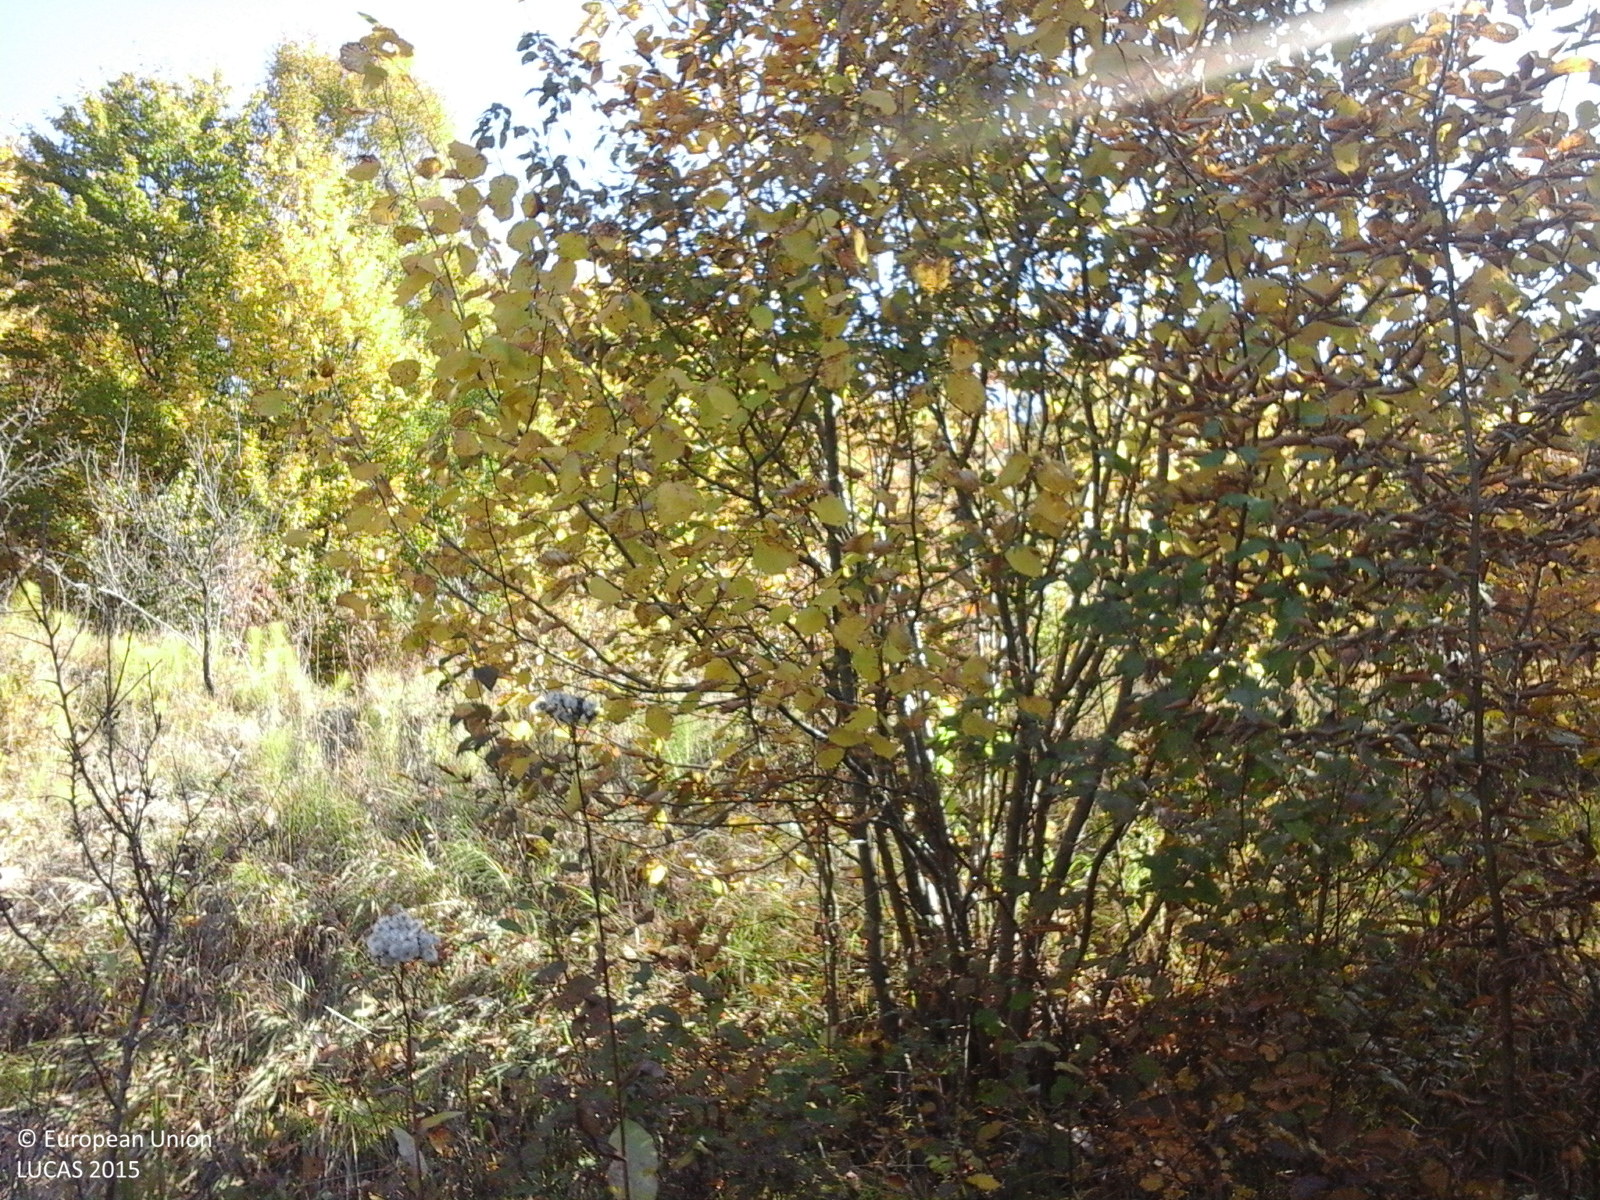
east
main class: Grassland
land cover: Grassland with sparse tree/shrub cover
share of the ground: > 75 %
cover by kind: herbaceous plants 85 %, shrubs 10 %, broadleaved forest trees 5 %
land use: Fallow land
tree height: < 5 m
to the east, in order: Grassland with sparse tree/shrub cover; Broadleaved woodland; Tracks; Broadleaved woodland; Tracks; Broadleaved woodland
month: October
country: RO
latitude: 45.1069
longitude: 26.4262
